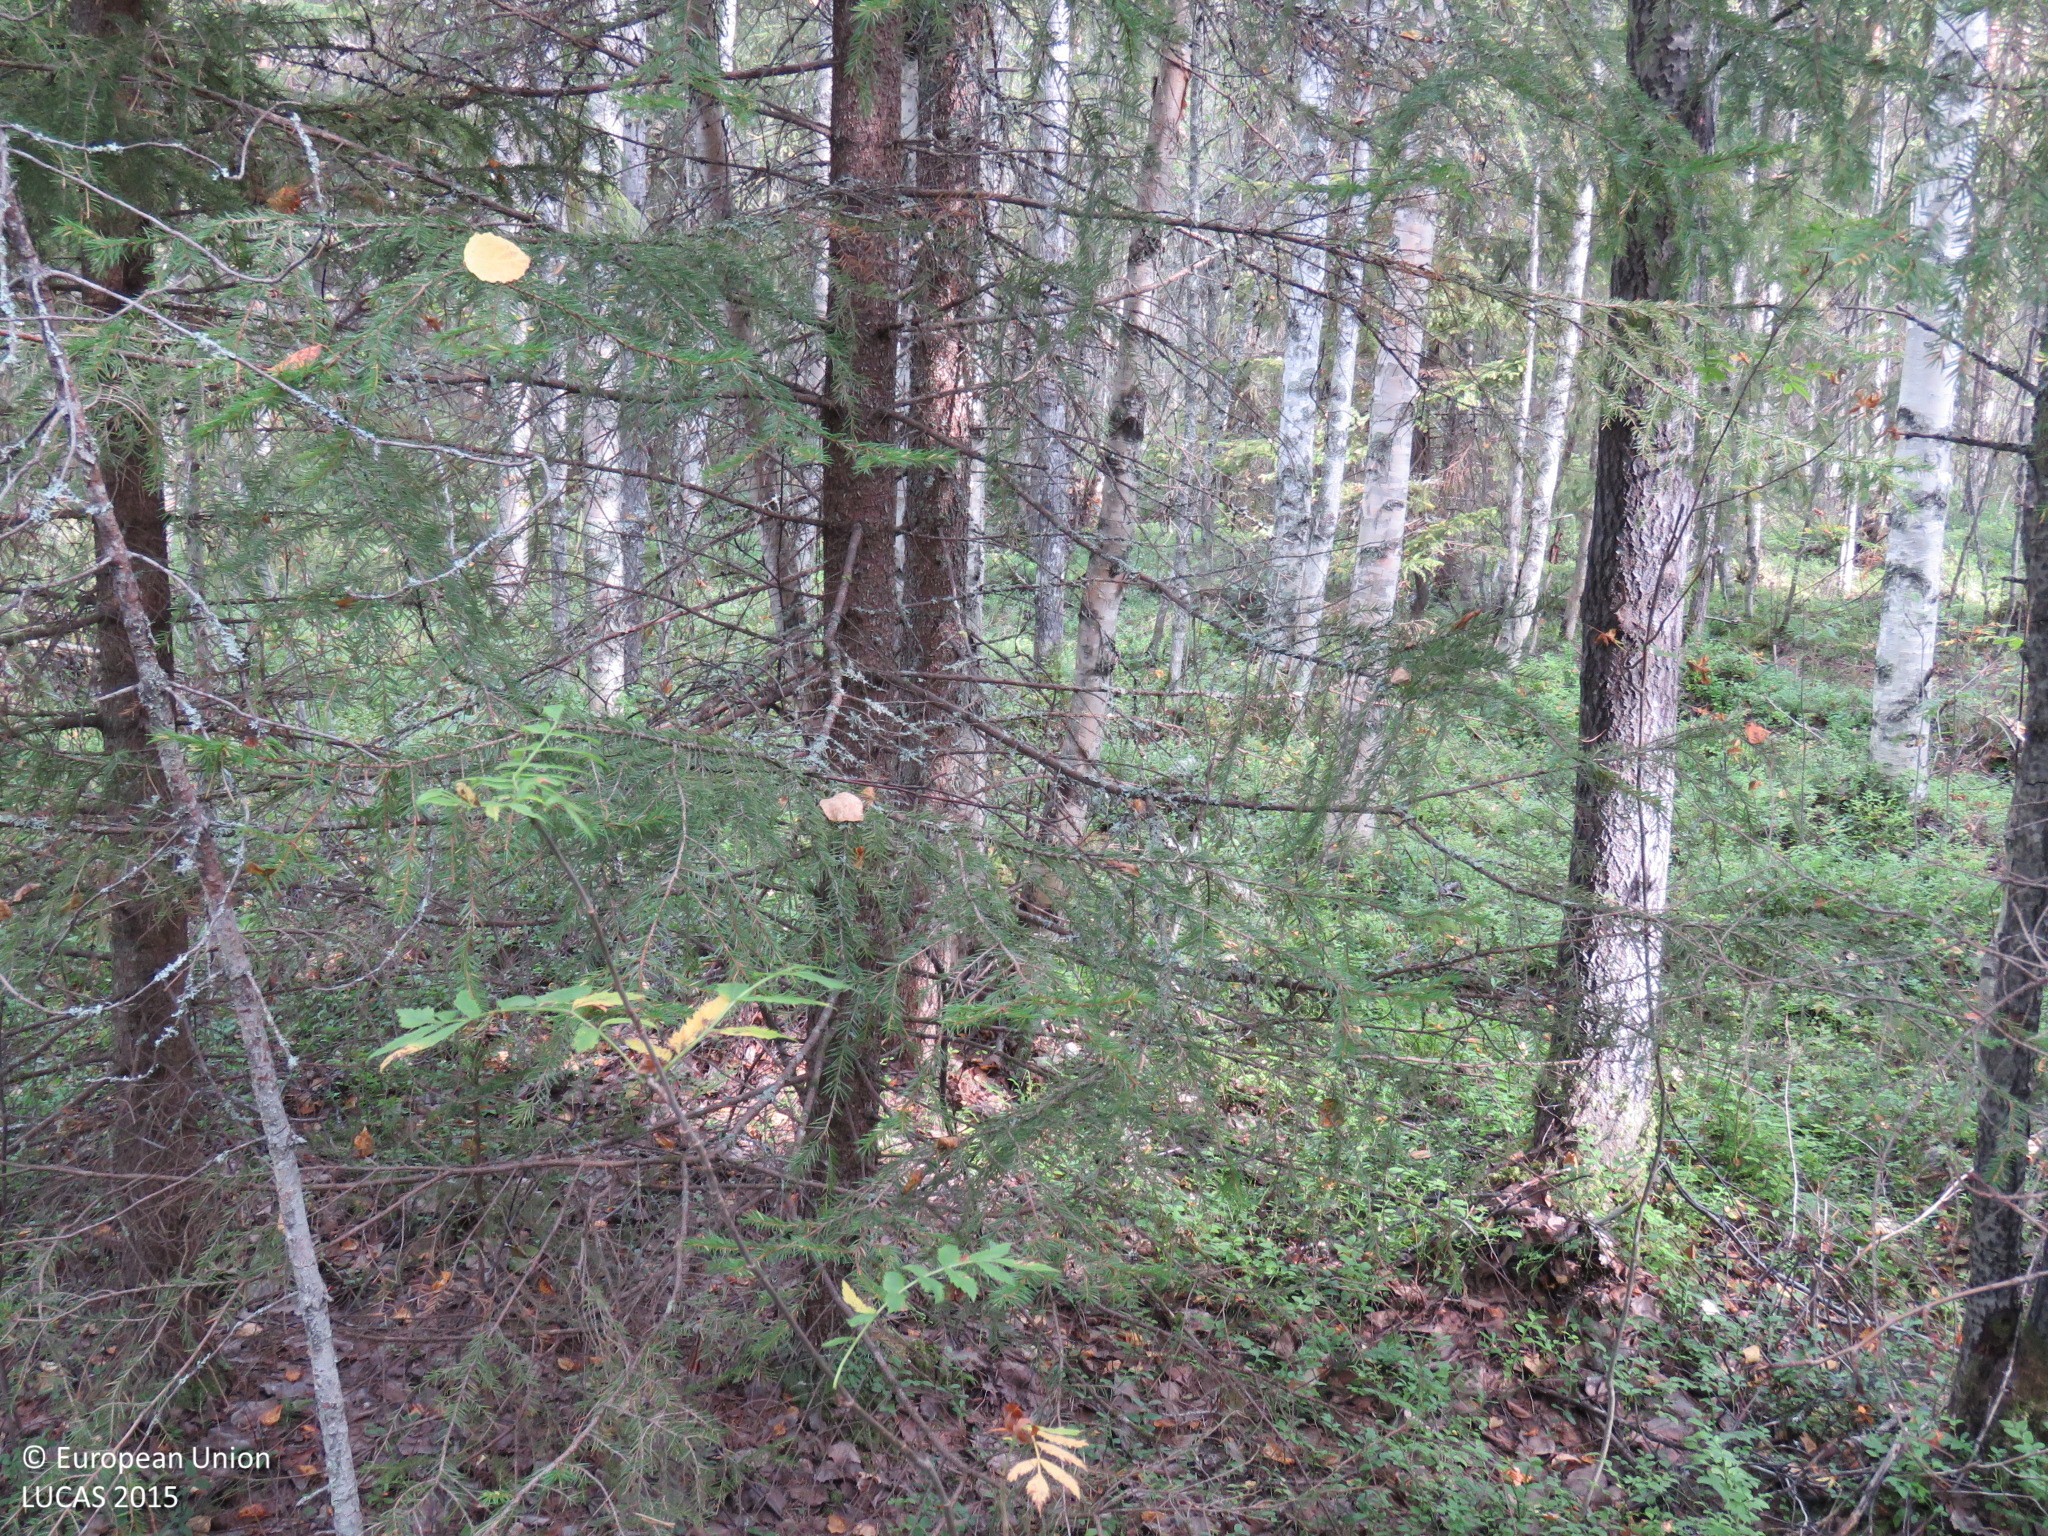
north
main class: Woodland
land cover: Other mixed woodland
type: boreal forest
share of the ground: > 75 %
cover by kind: coniferous forest trees 50 %, broadleaved forest trees 40 %, shrubs 10 %
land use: Forestry
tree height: > 5 m
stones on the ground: < 10 %
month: August
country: FI
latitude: 64.9549
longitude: 26.1255
